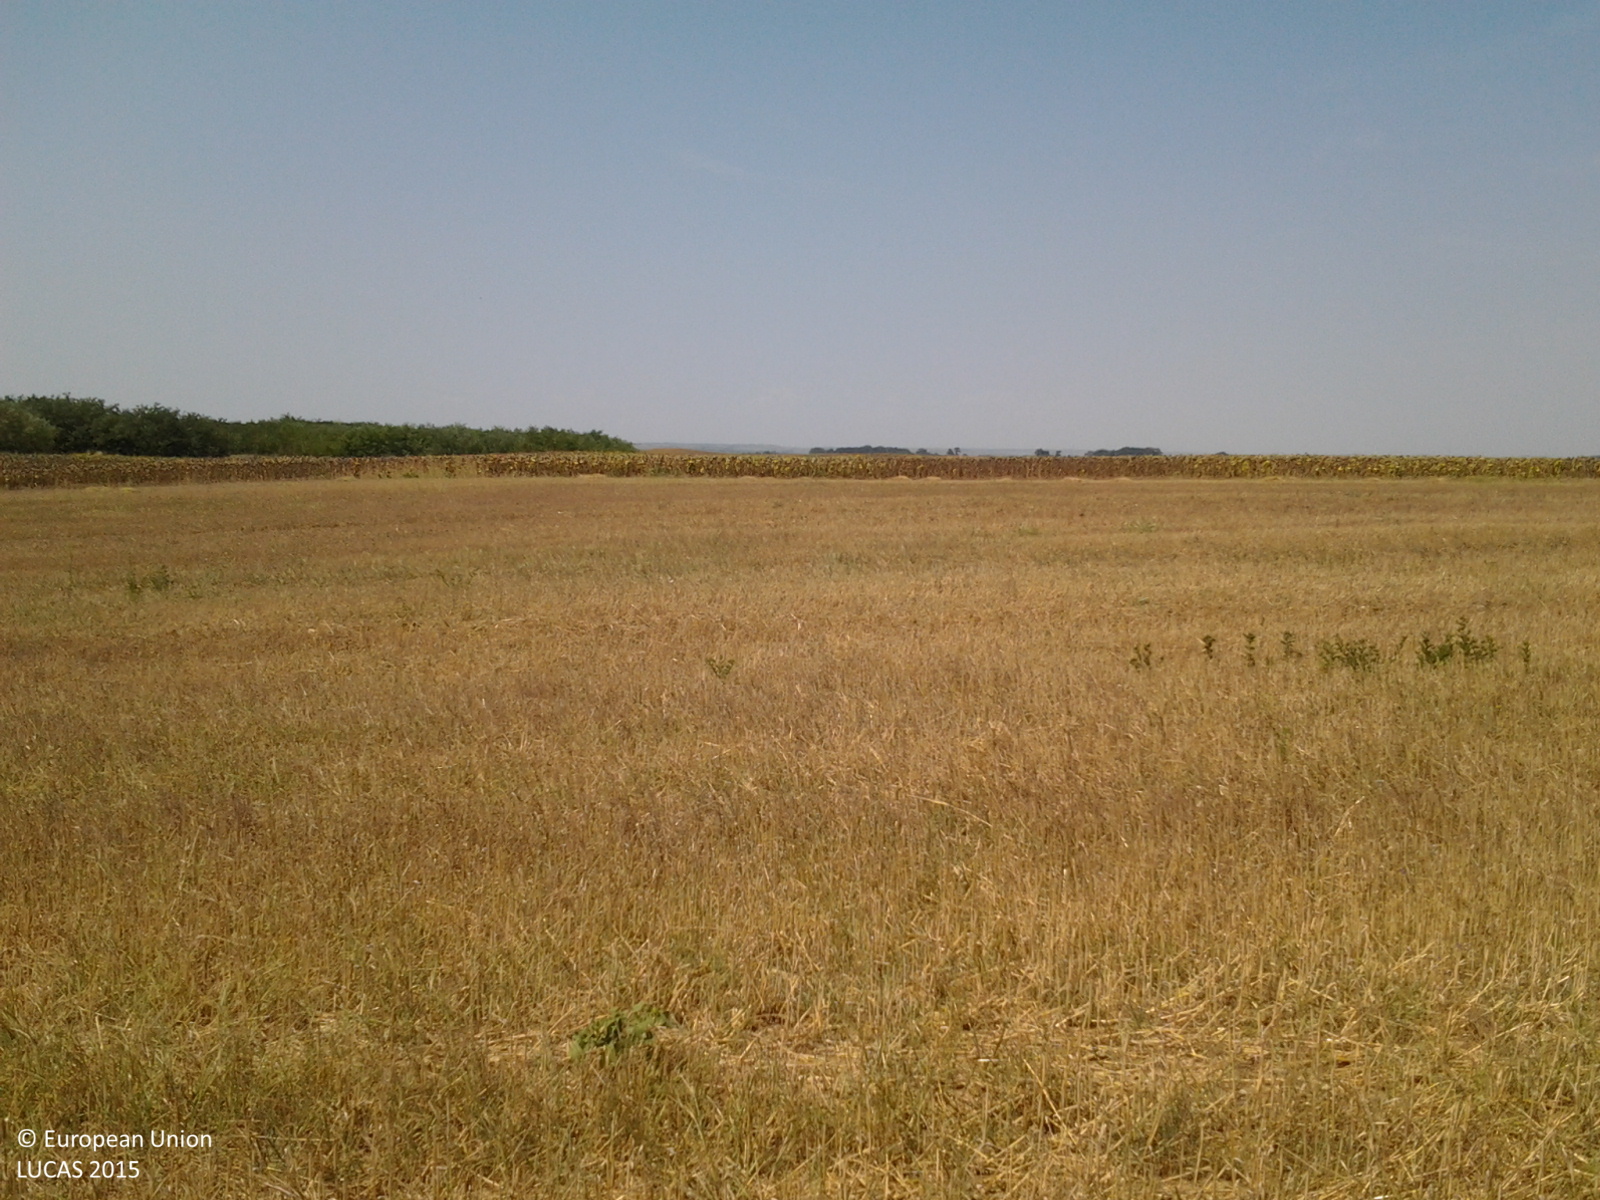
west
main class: Cropland
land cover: Common wheat
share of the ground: 50 - 75 %
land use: Agriculture (excluding fallow land and kitchen gardens)
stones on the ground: < 10 %
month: August
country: RO
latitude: 43.8678
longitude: 22.9179
